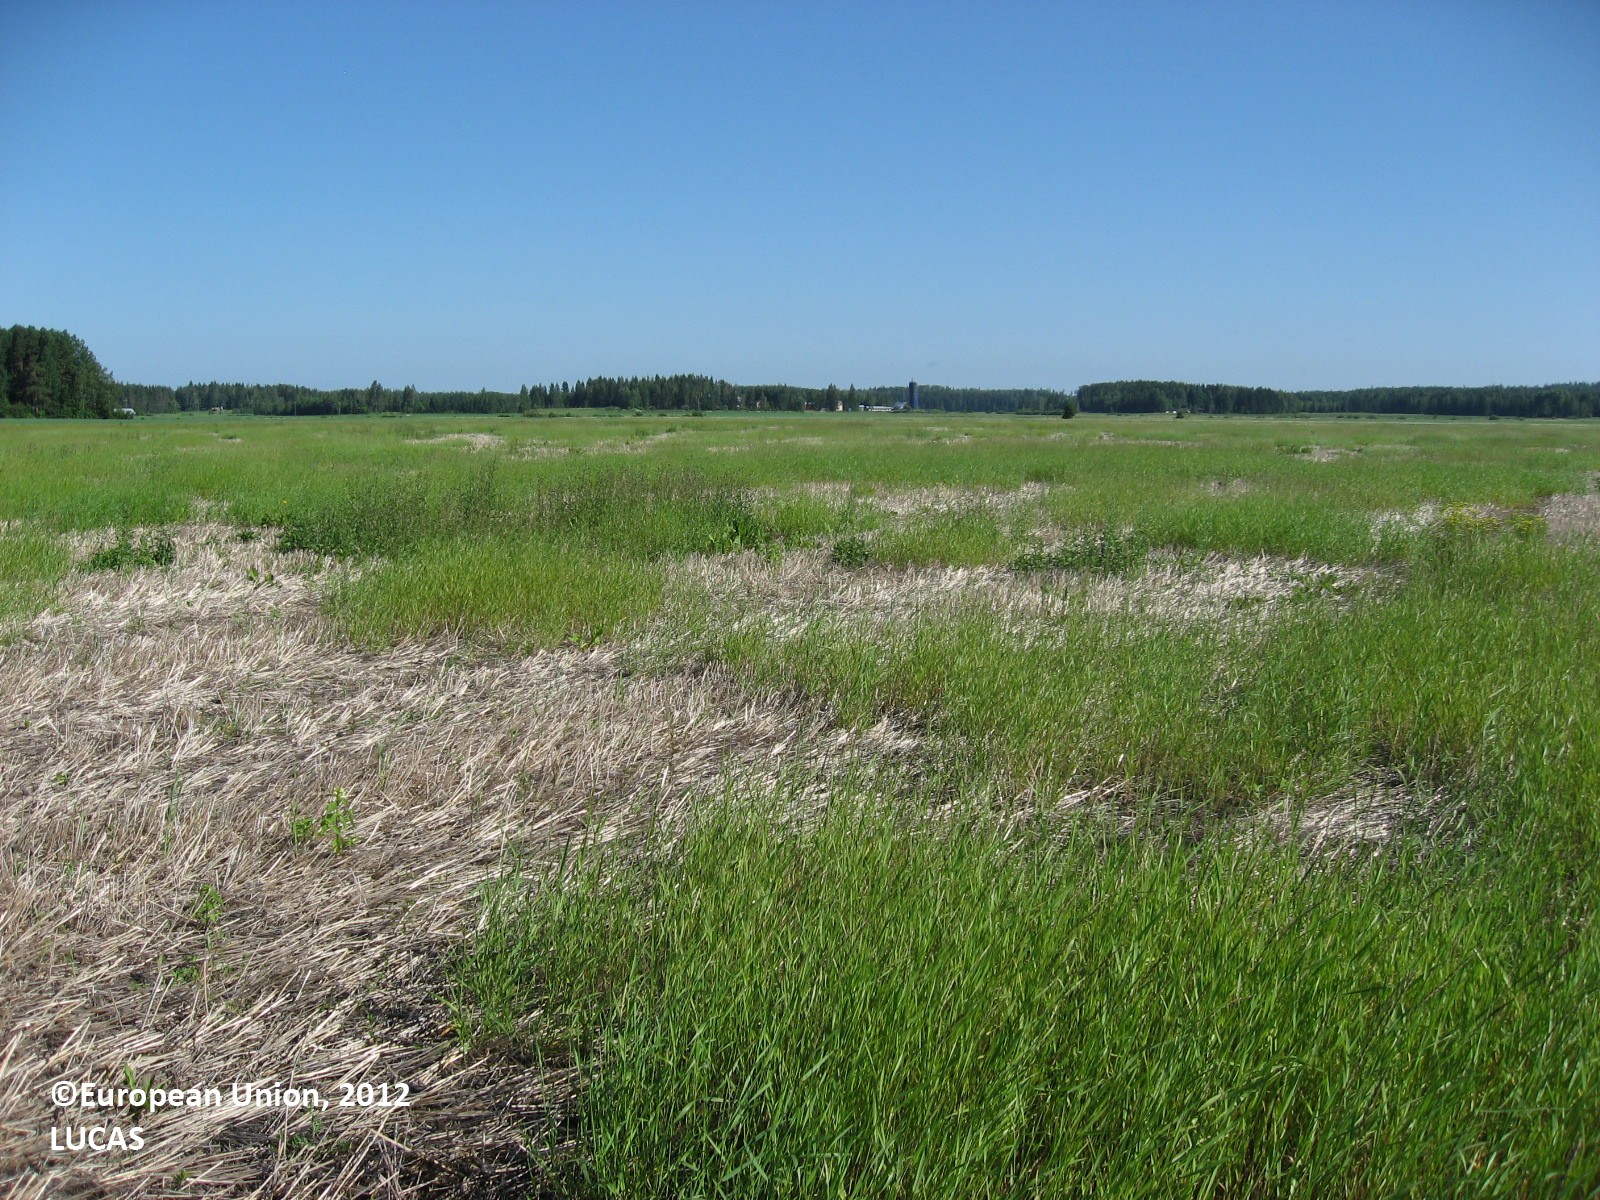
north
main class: Grassland
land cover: Spontaneously vegetated surfaces
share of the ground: 50 - 75 %
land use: Fallow land
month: July
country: FI
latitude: 60.8478
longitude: 26.2865
